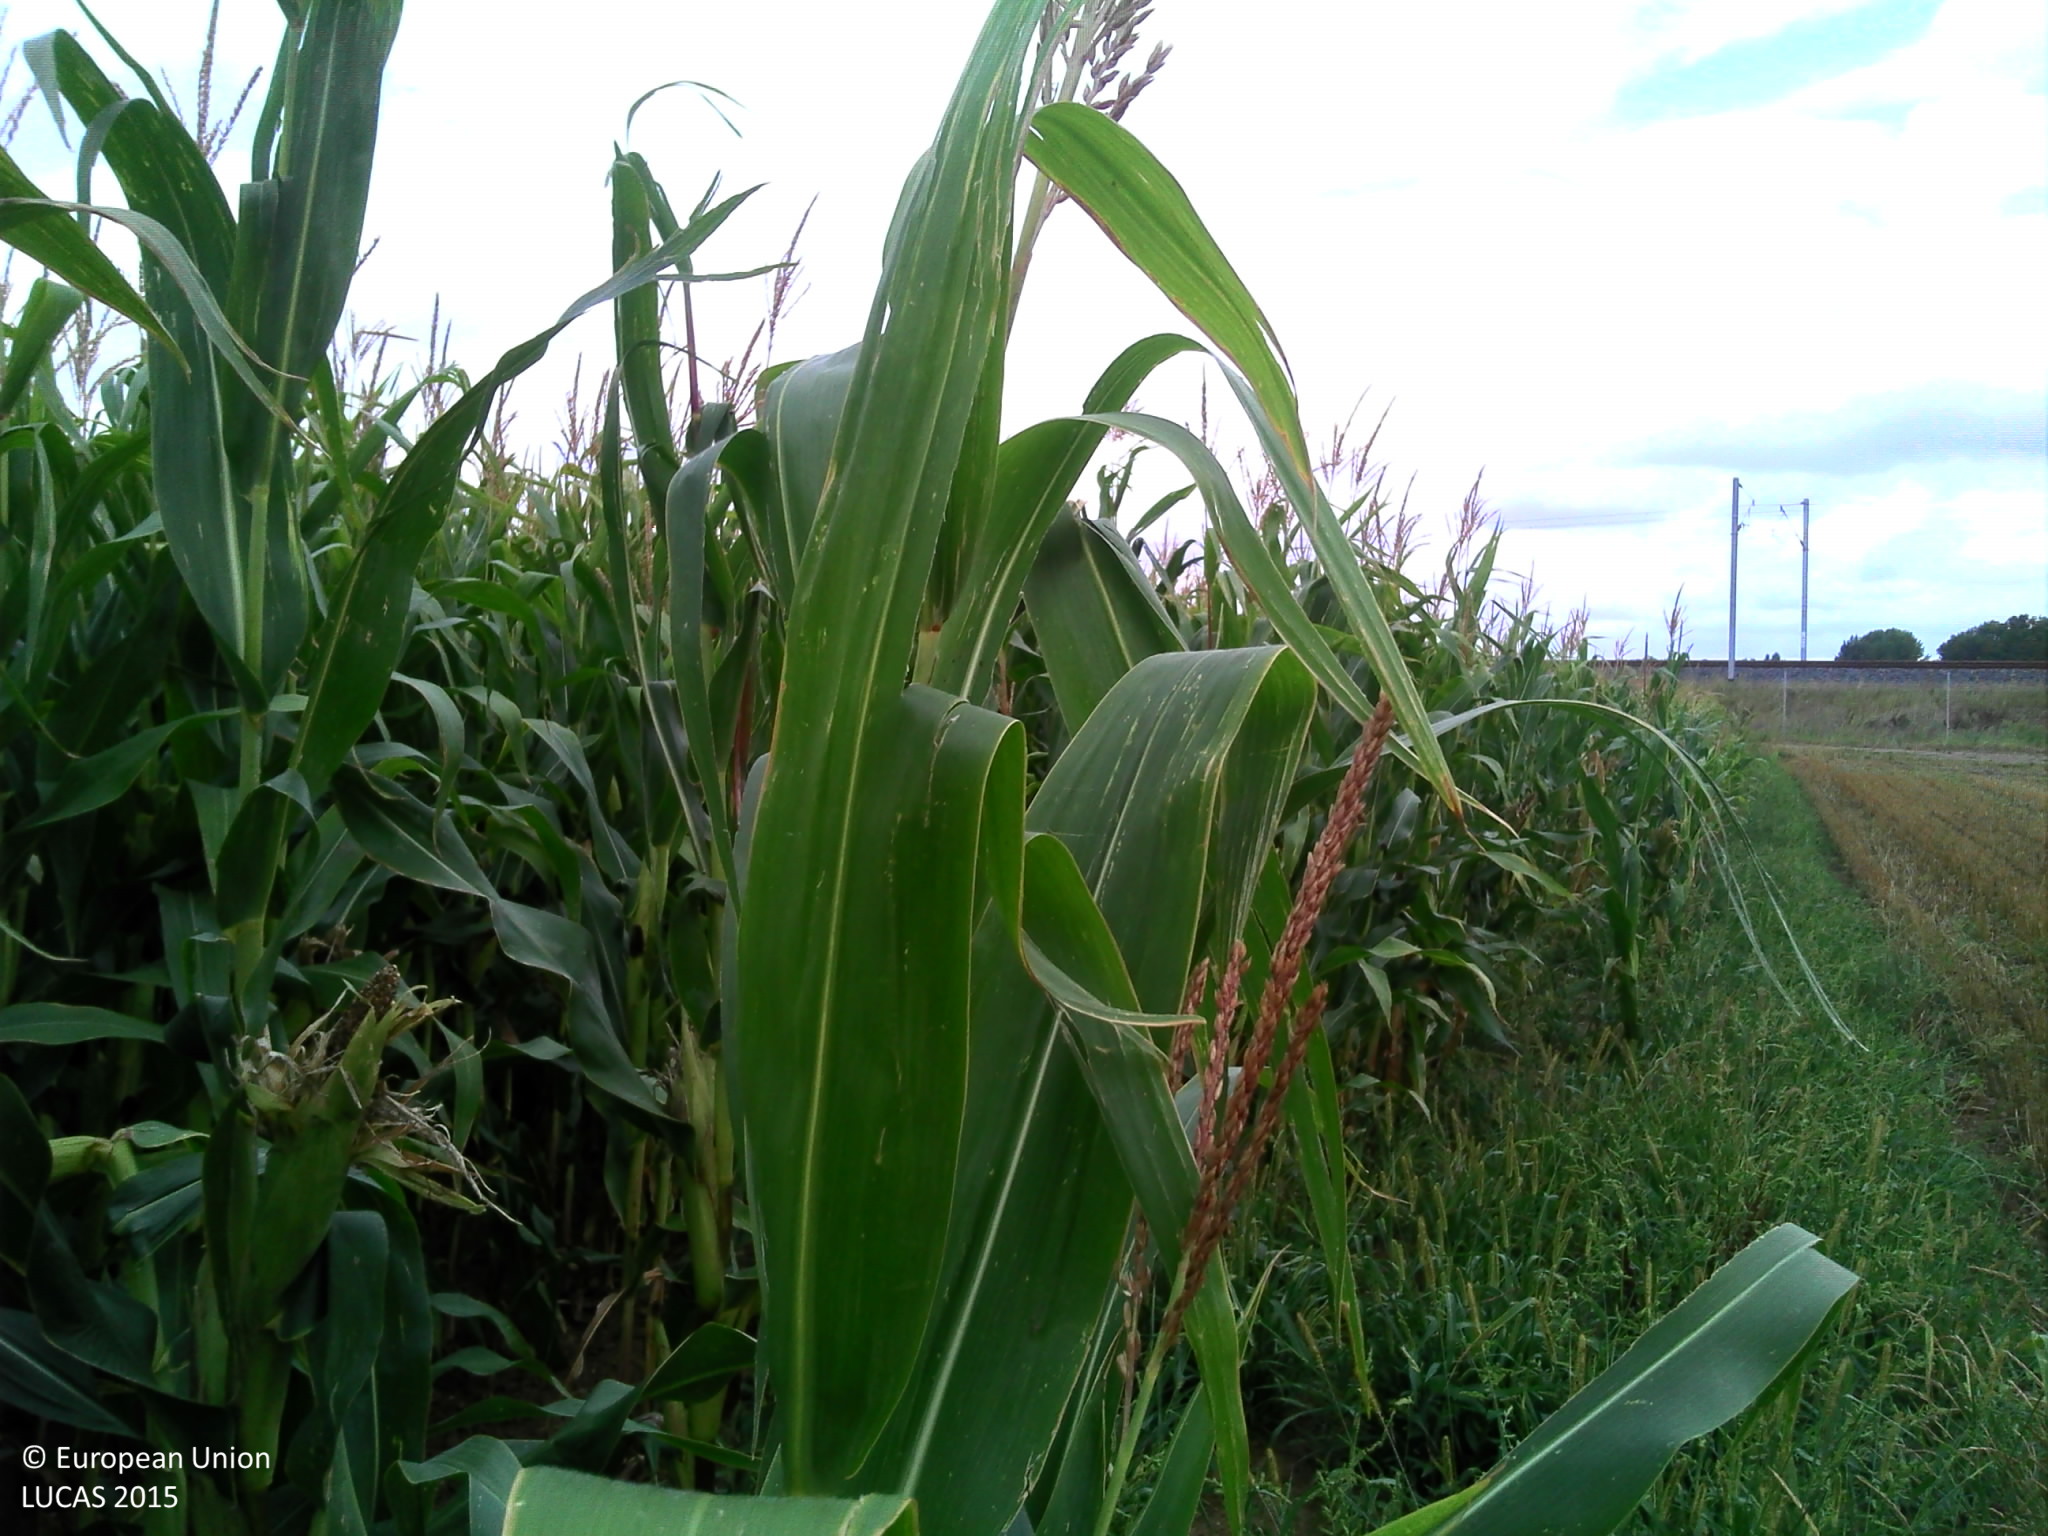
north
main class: Cropland
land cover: Maize
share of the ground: > 75 %
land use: Agriculture (excluding fallow land and kitchen gardens)
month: August
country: FR
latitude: 48.7019
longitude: 7.6229
